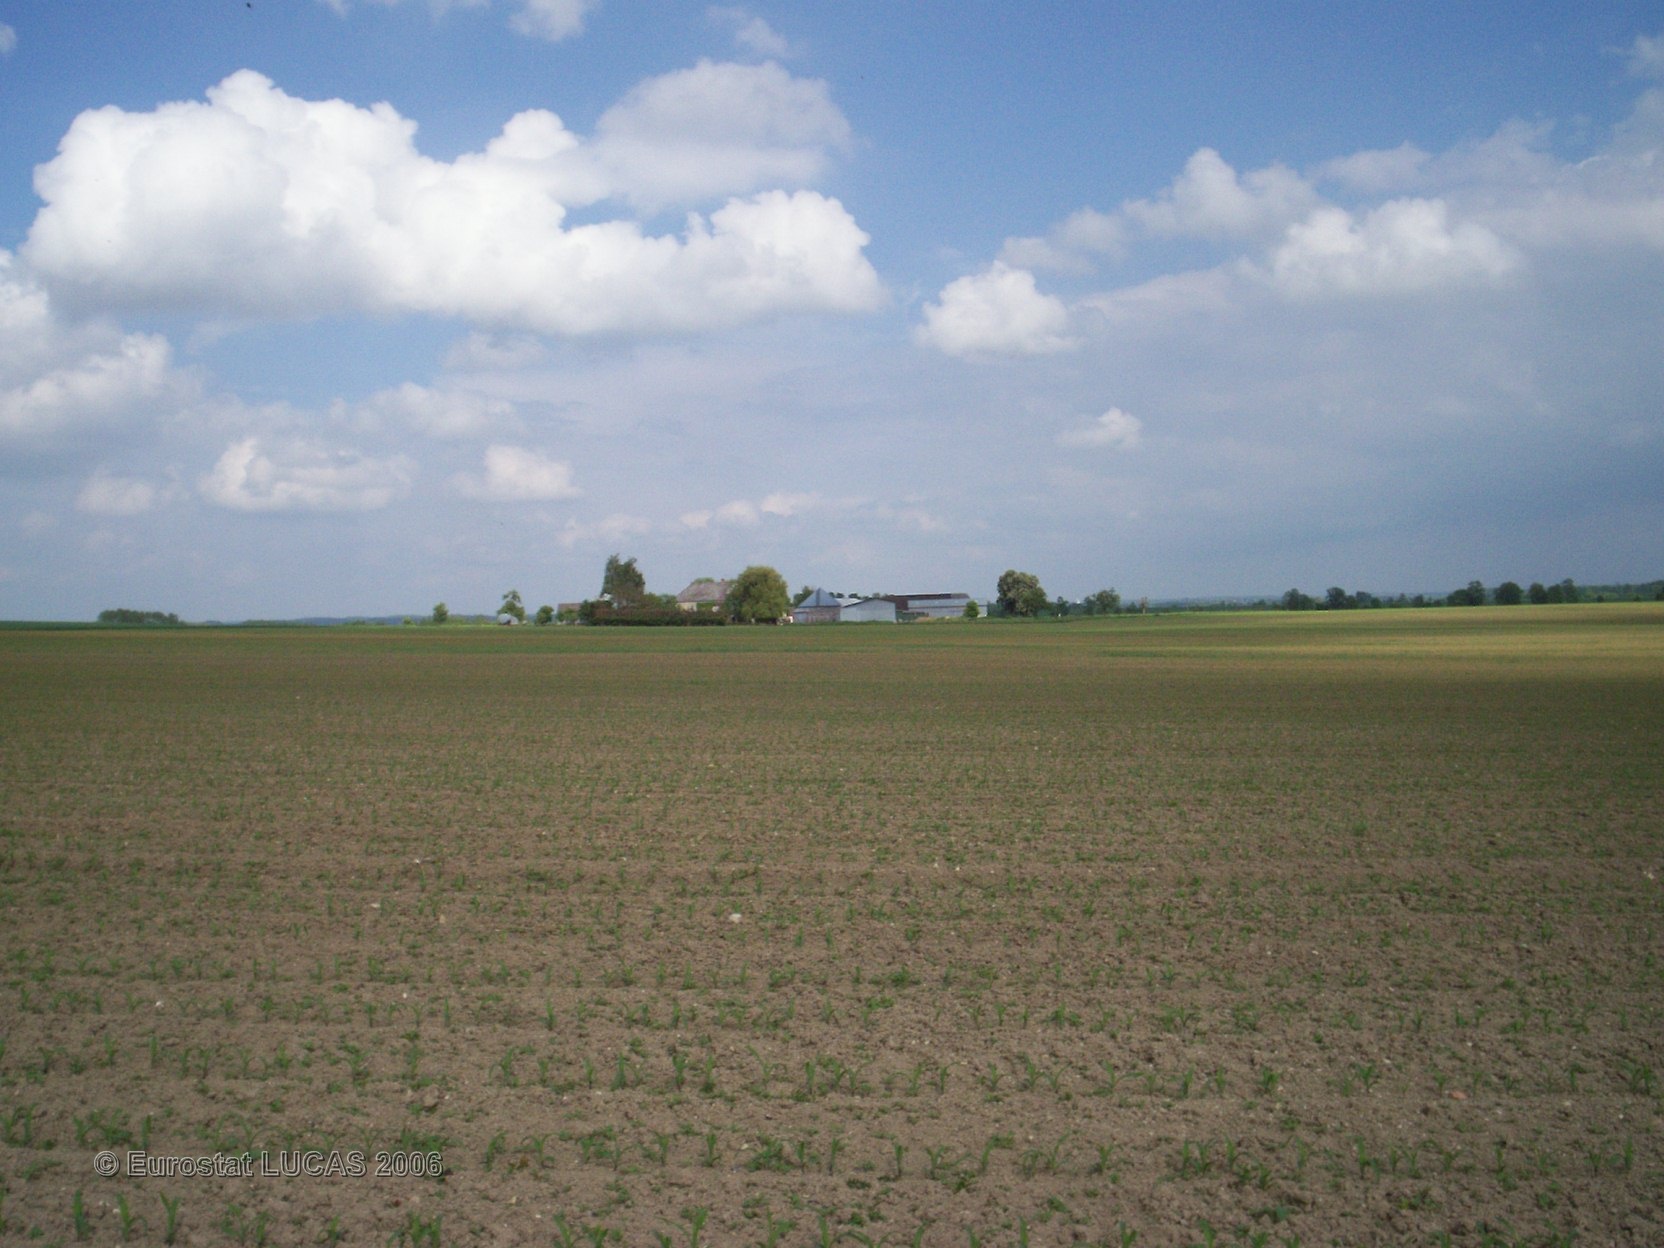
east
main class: Cropland
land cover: Maize
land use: Agriculture (excluding fallow land and kitchen gardens)
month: May
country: FR
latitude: 49.5763
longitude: 4.3672
